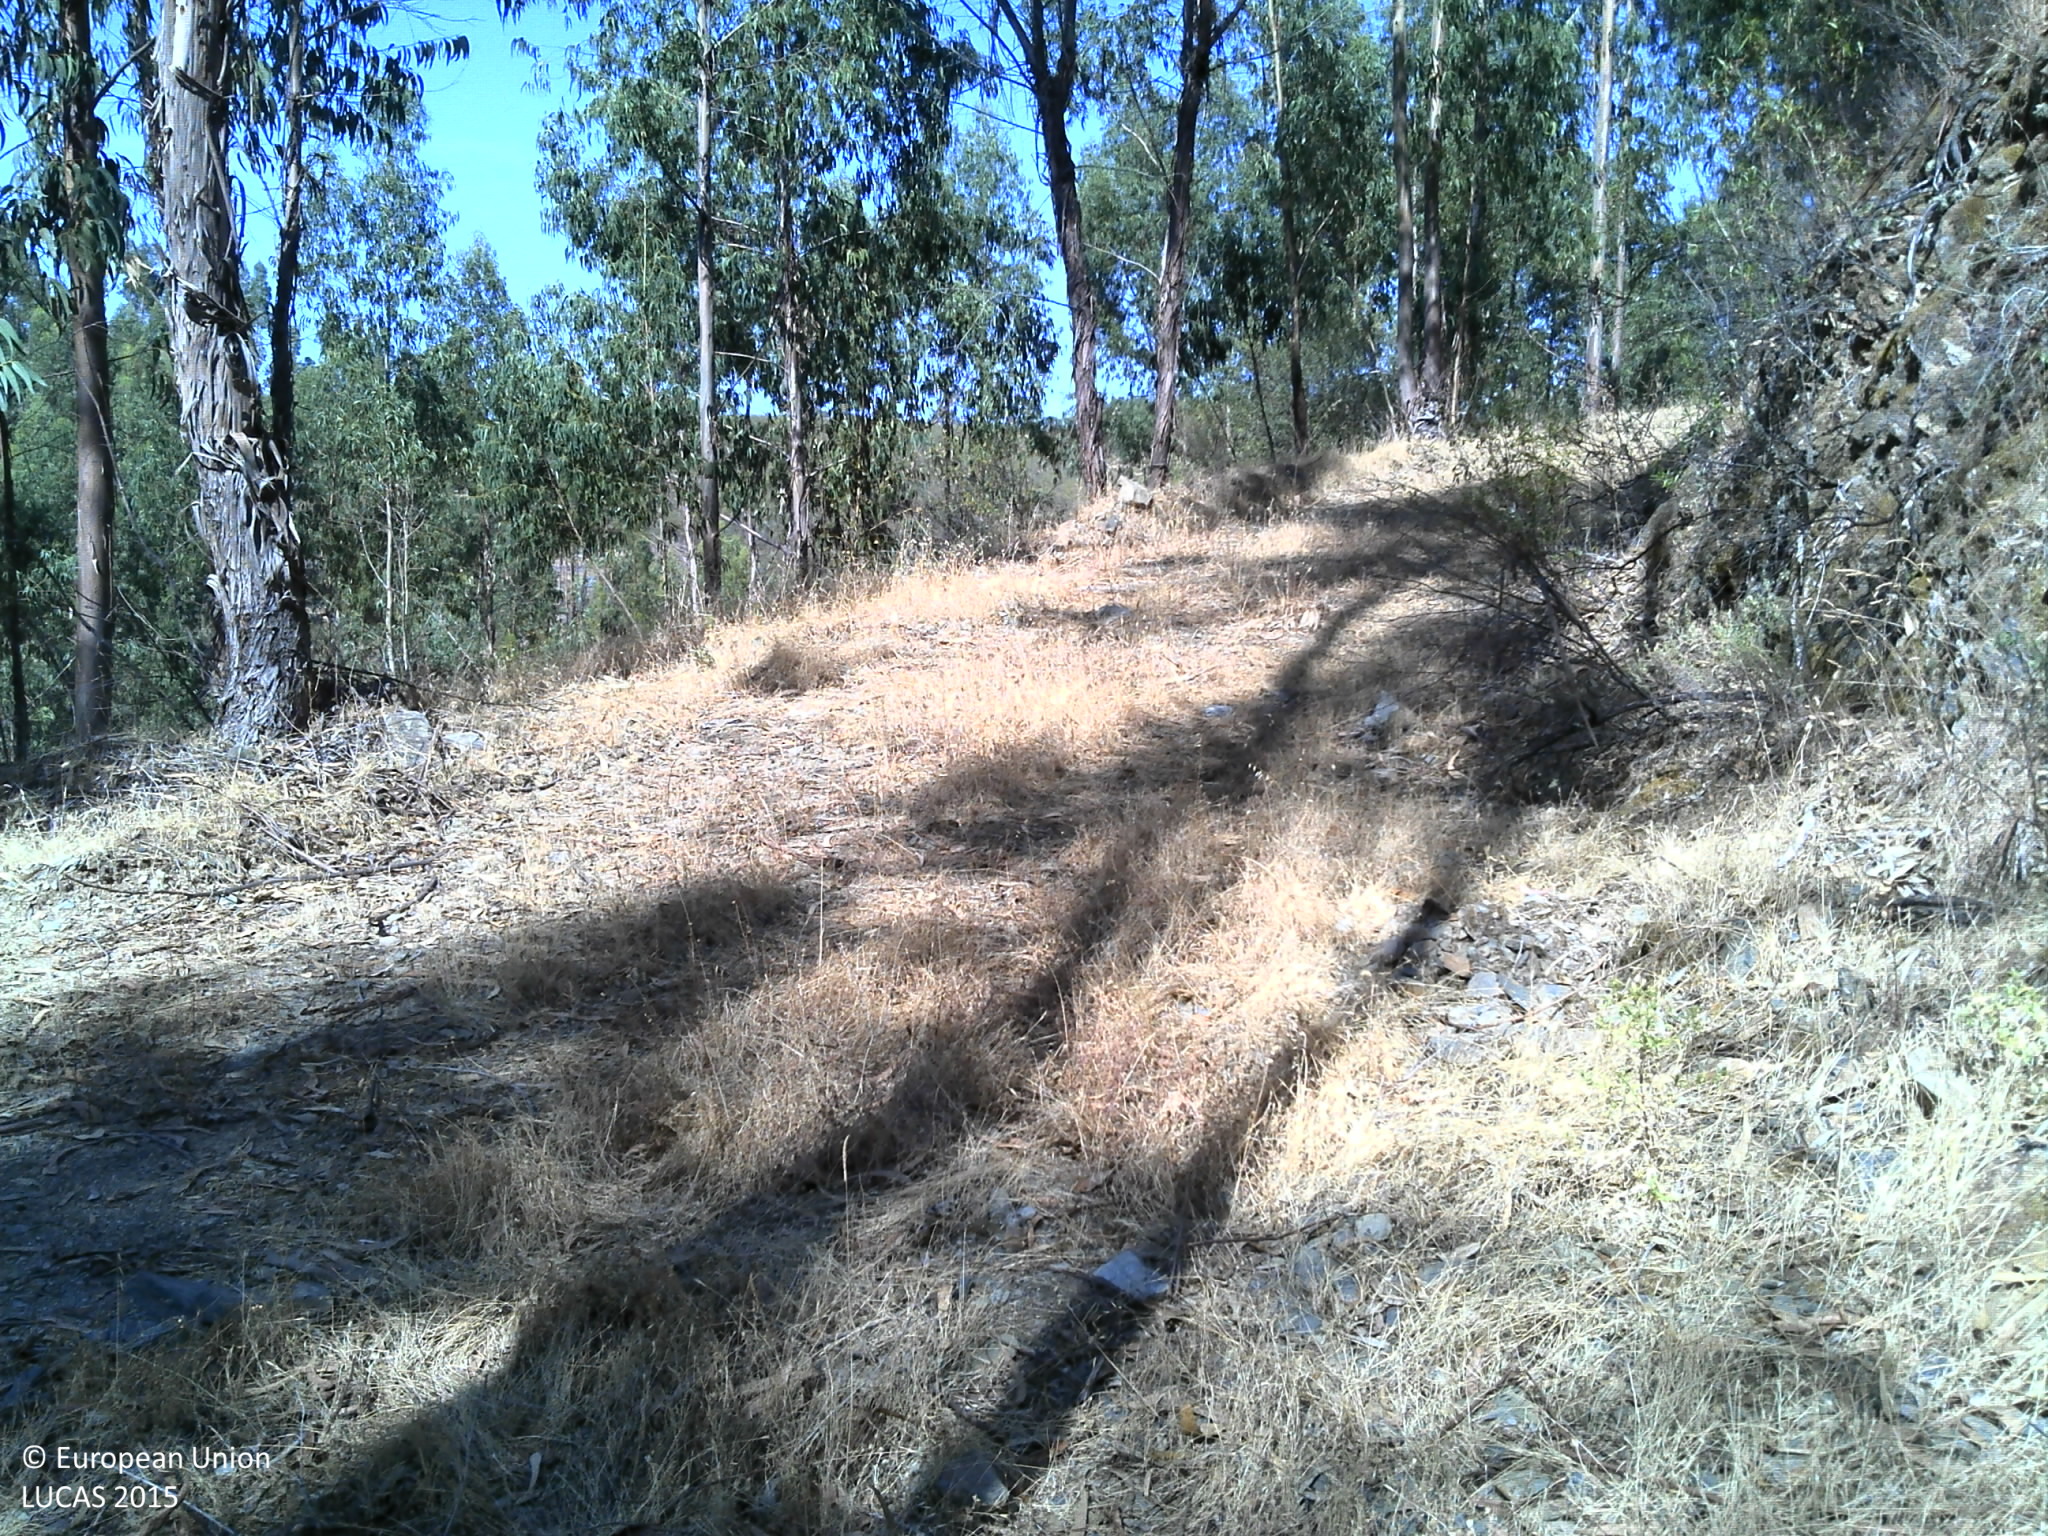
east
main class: Woodland
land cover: Broadleaved woodland
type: exotic forest
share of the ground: 10 - 25 %
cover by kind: unconsolidated bare surface 50 %, consolidated bare surface 20 %, broadleaved forest trees 15 %, shrubs 15 %
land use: Forestry
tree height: > 5 m
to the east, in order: Tracks; Broadleaved woodland; Tracks; Broadleaved woodland; Tracks; Dry stone walls; Shrubland without tree cover
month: July
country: PT
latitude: 39.5875
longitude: -7.7886
